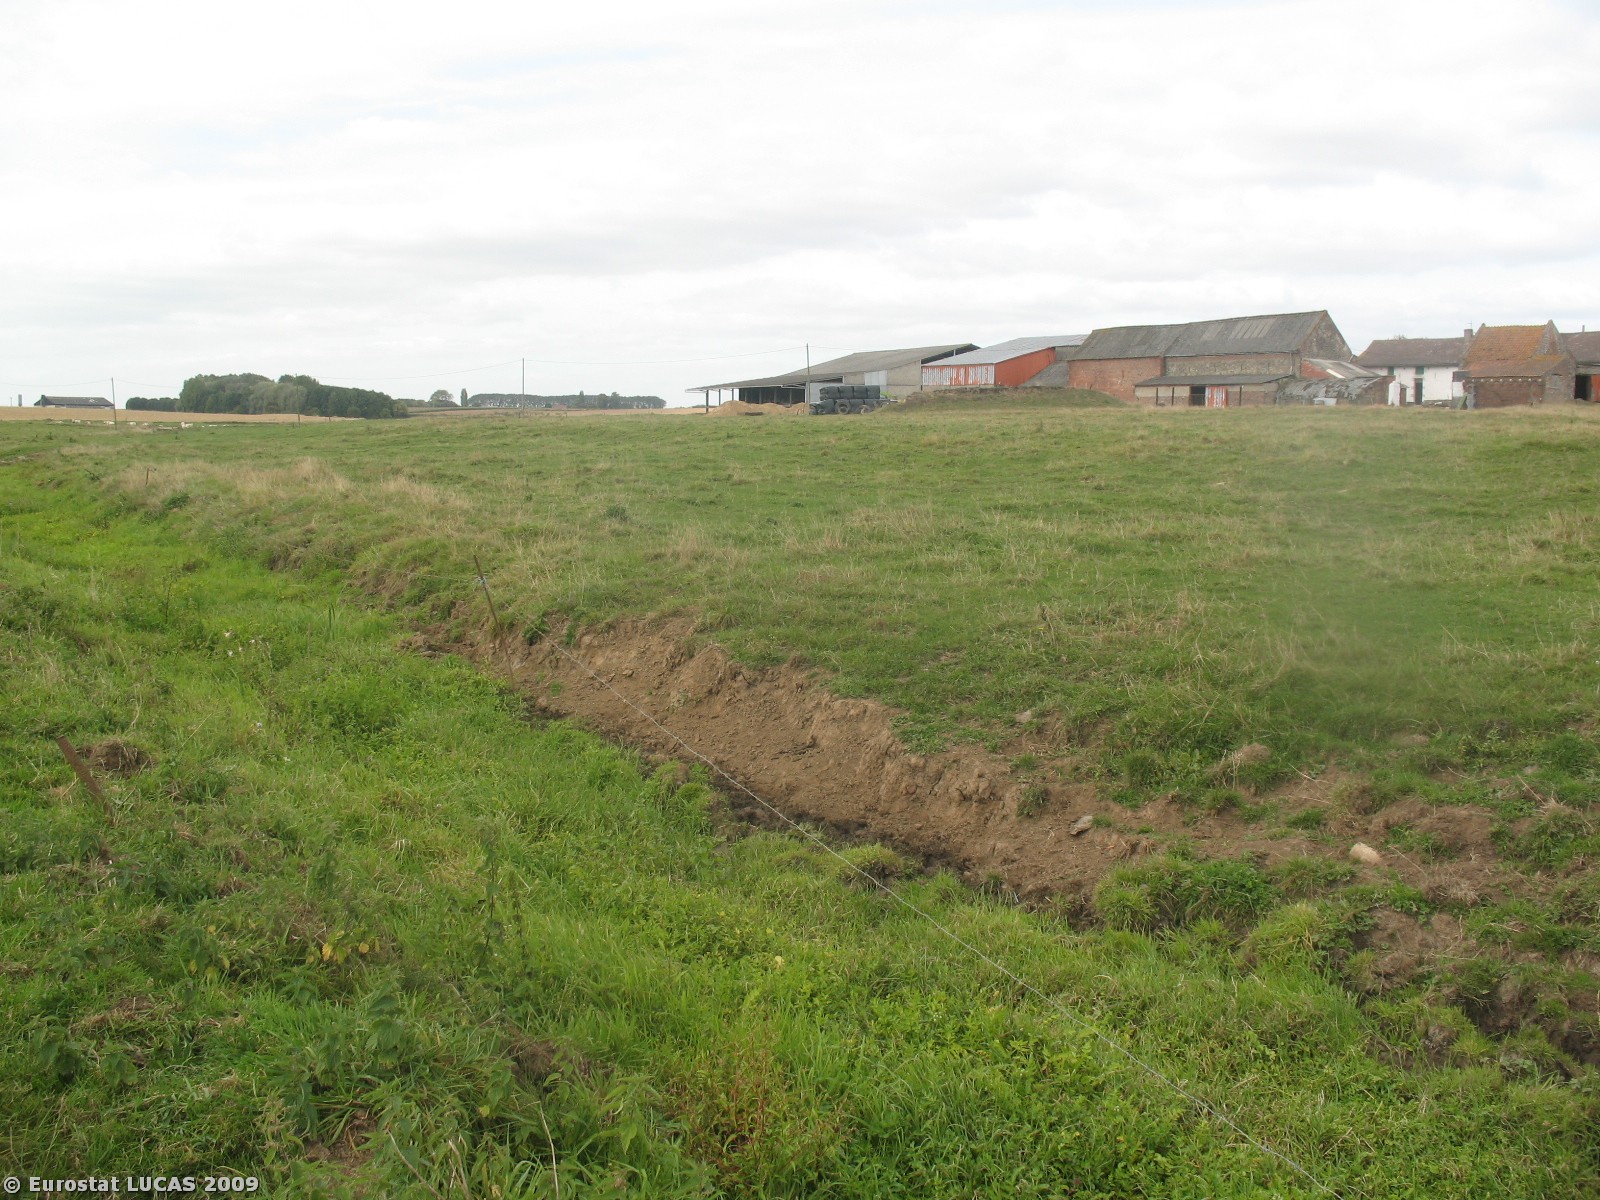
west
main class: Grassland
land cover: Grassland without tree/shrub cover
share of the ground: > 75 %
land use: Agriculture (excluding fallow land and kitchen gardens)
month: September
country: BE
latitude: 50.3563
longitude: 4.1053
